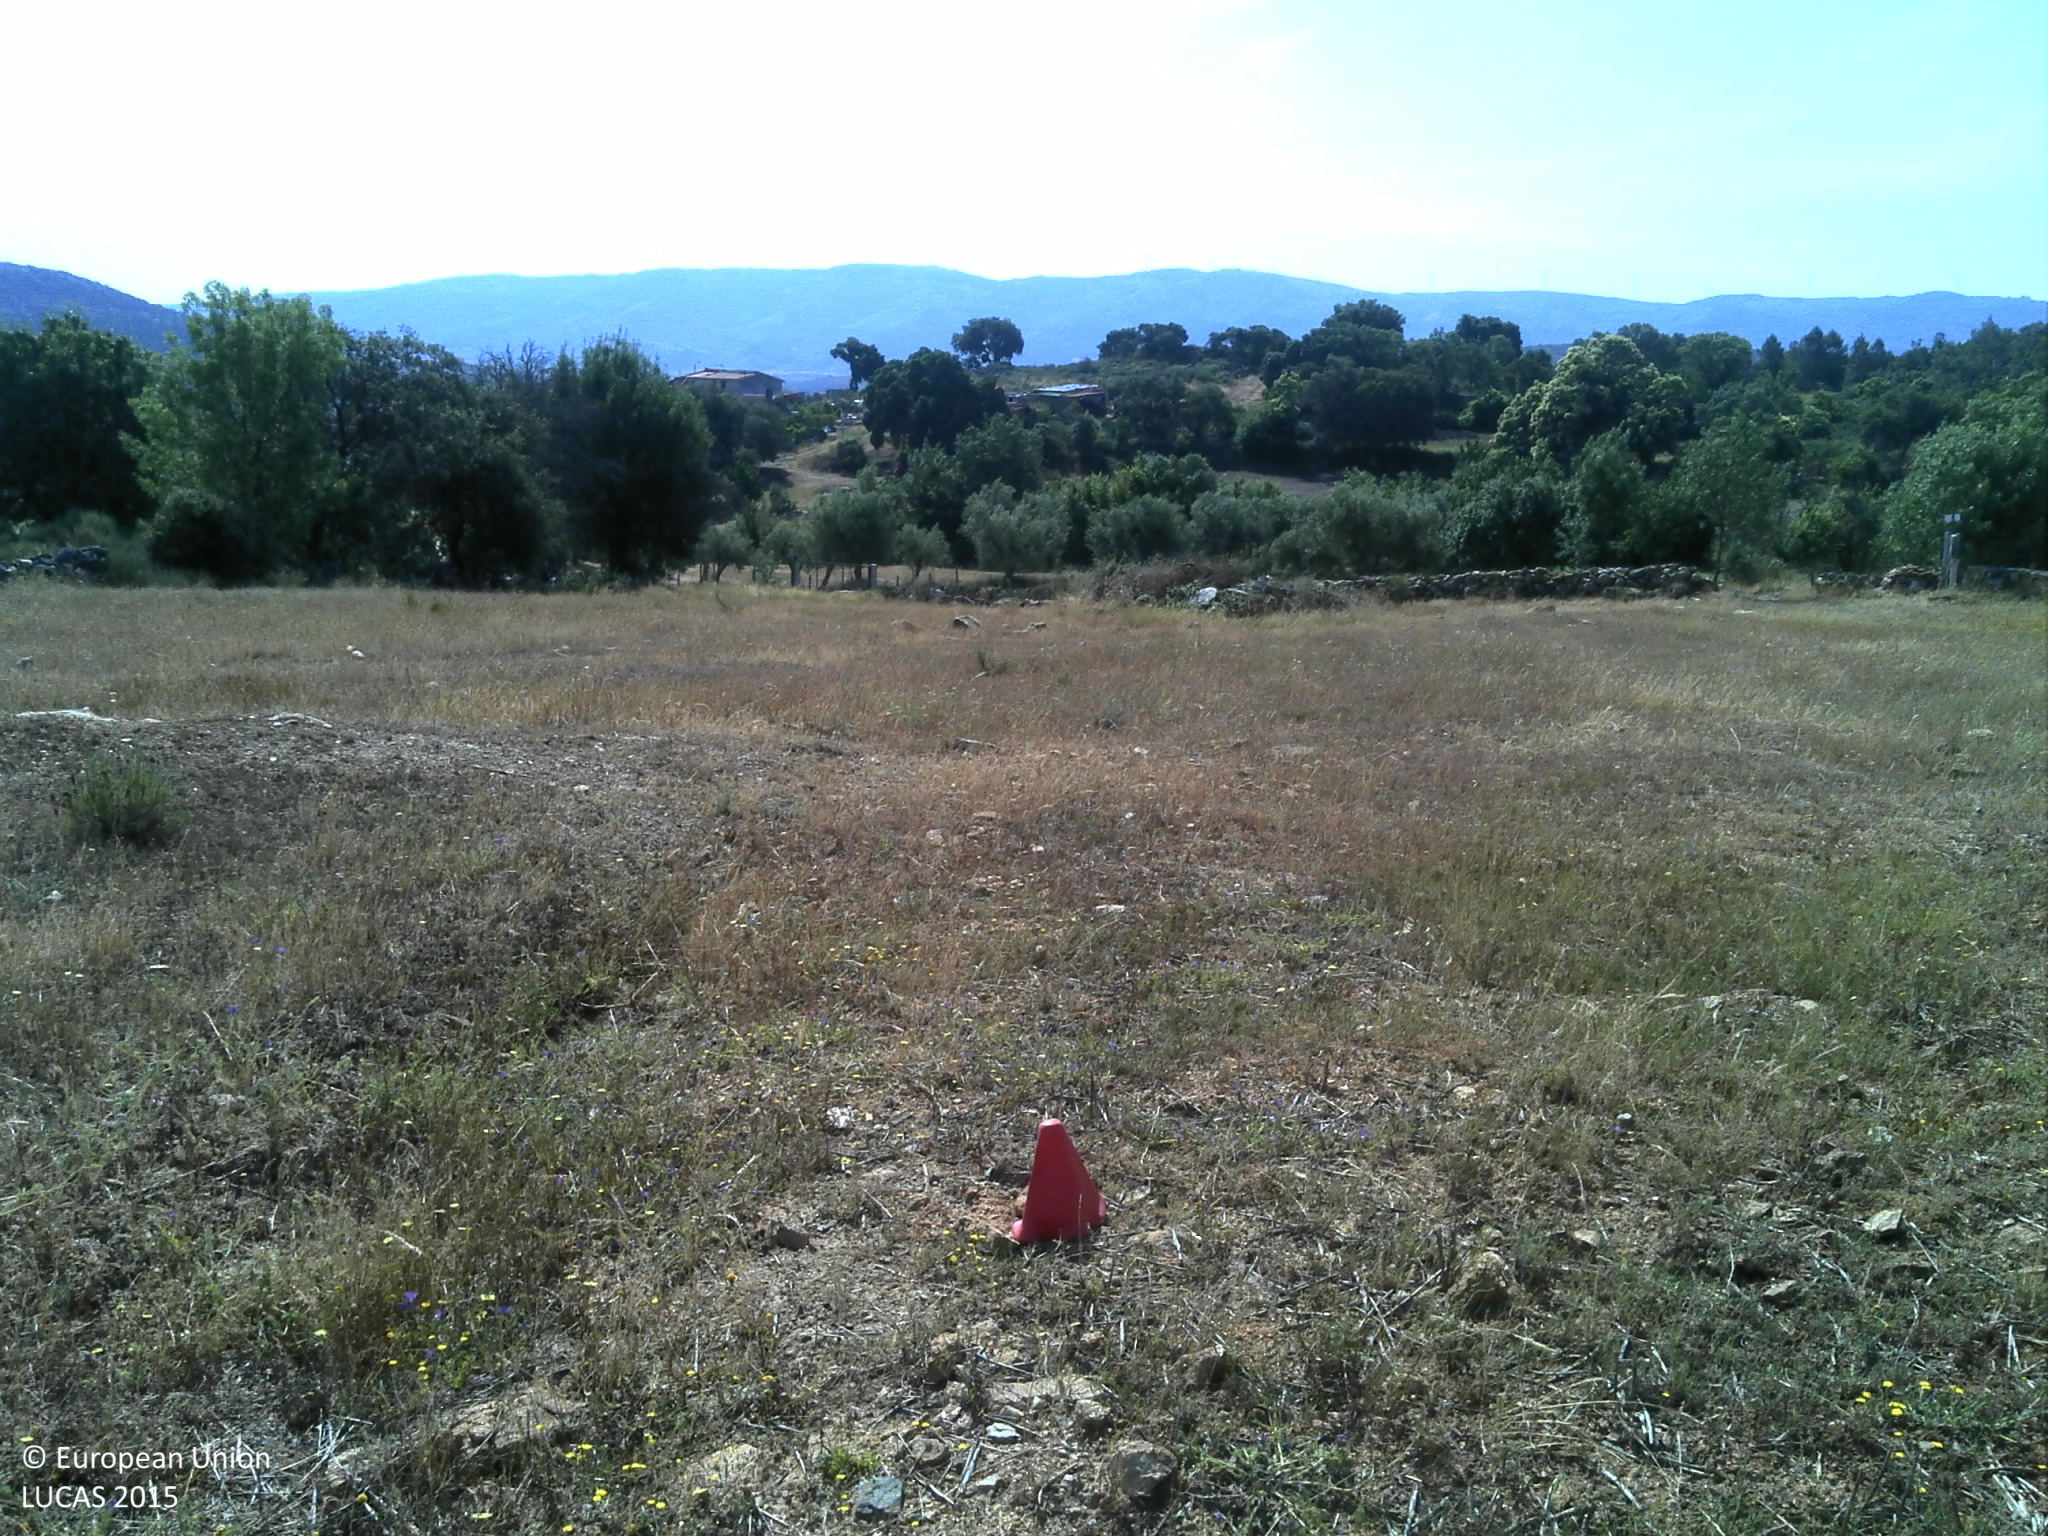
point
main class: Grassland
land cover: Grassland without tree/shrub cover
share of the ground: 25 - 50 %
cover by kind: unconsolidated bare surface 60 %, herbaceous plants 30 %, consolidated bare surface 10 %
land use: Agriculture (excluding fallow land and kitchen gardens)
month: June
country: PT
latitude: 41.5097
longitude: -7.0453
